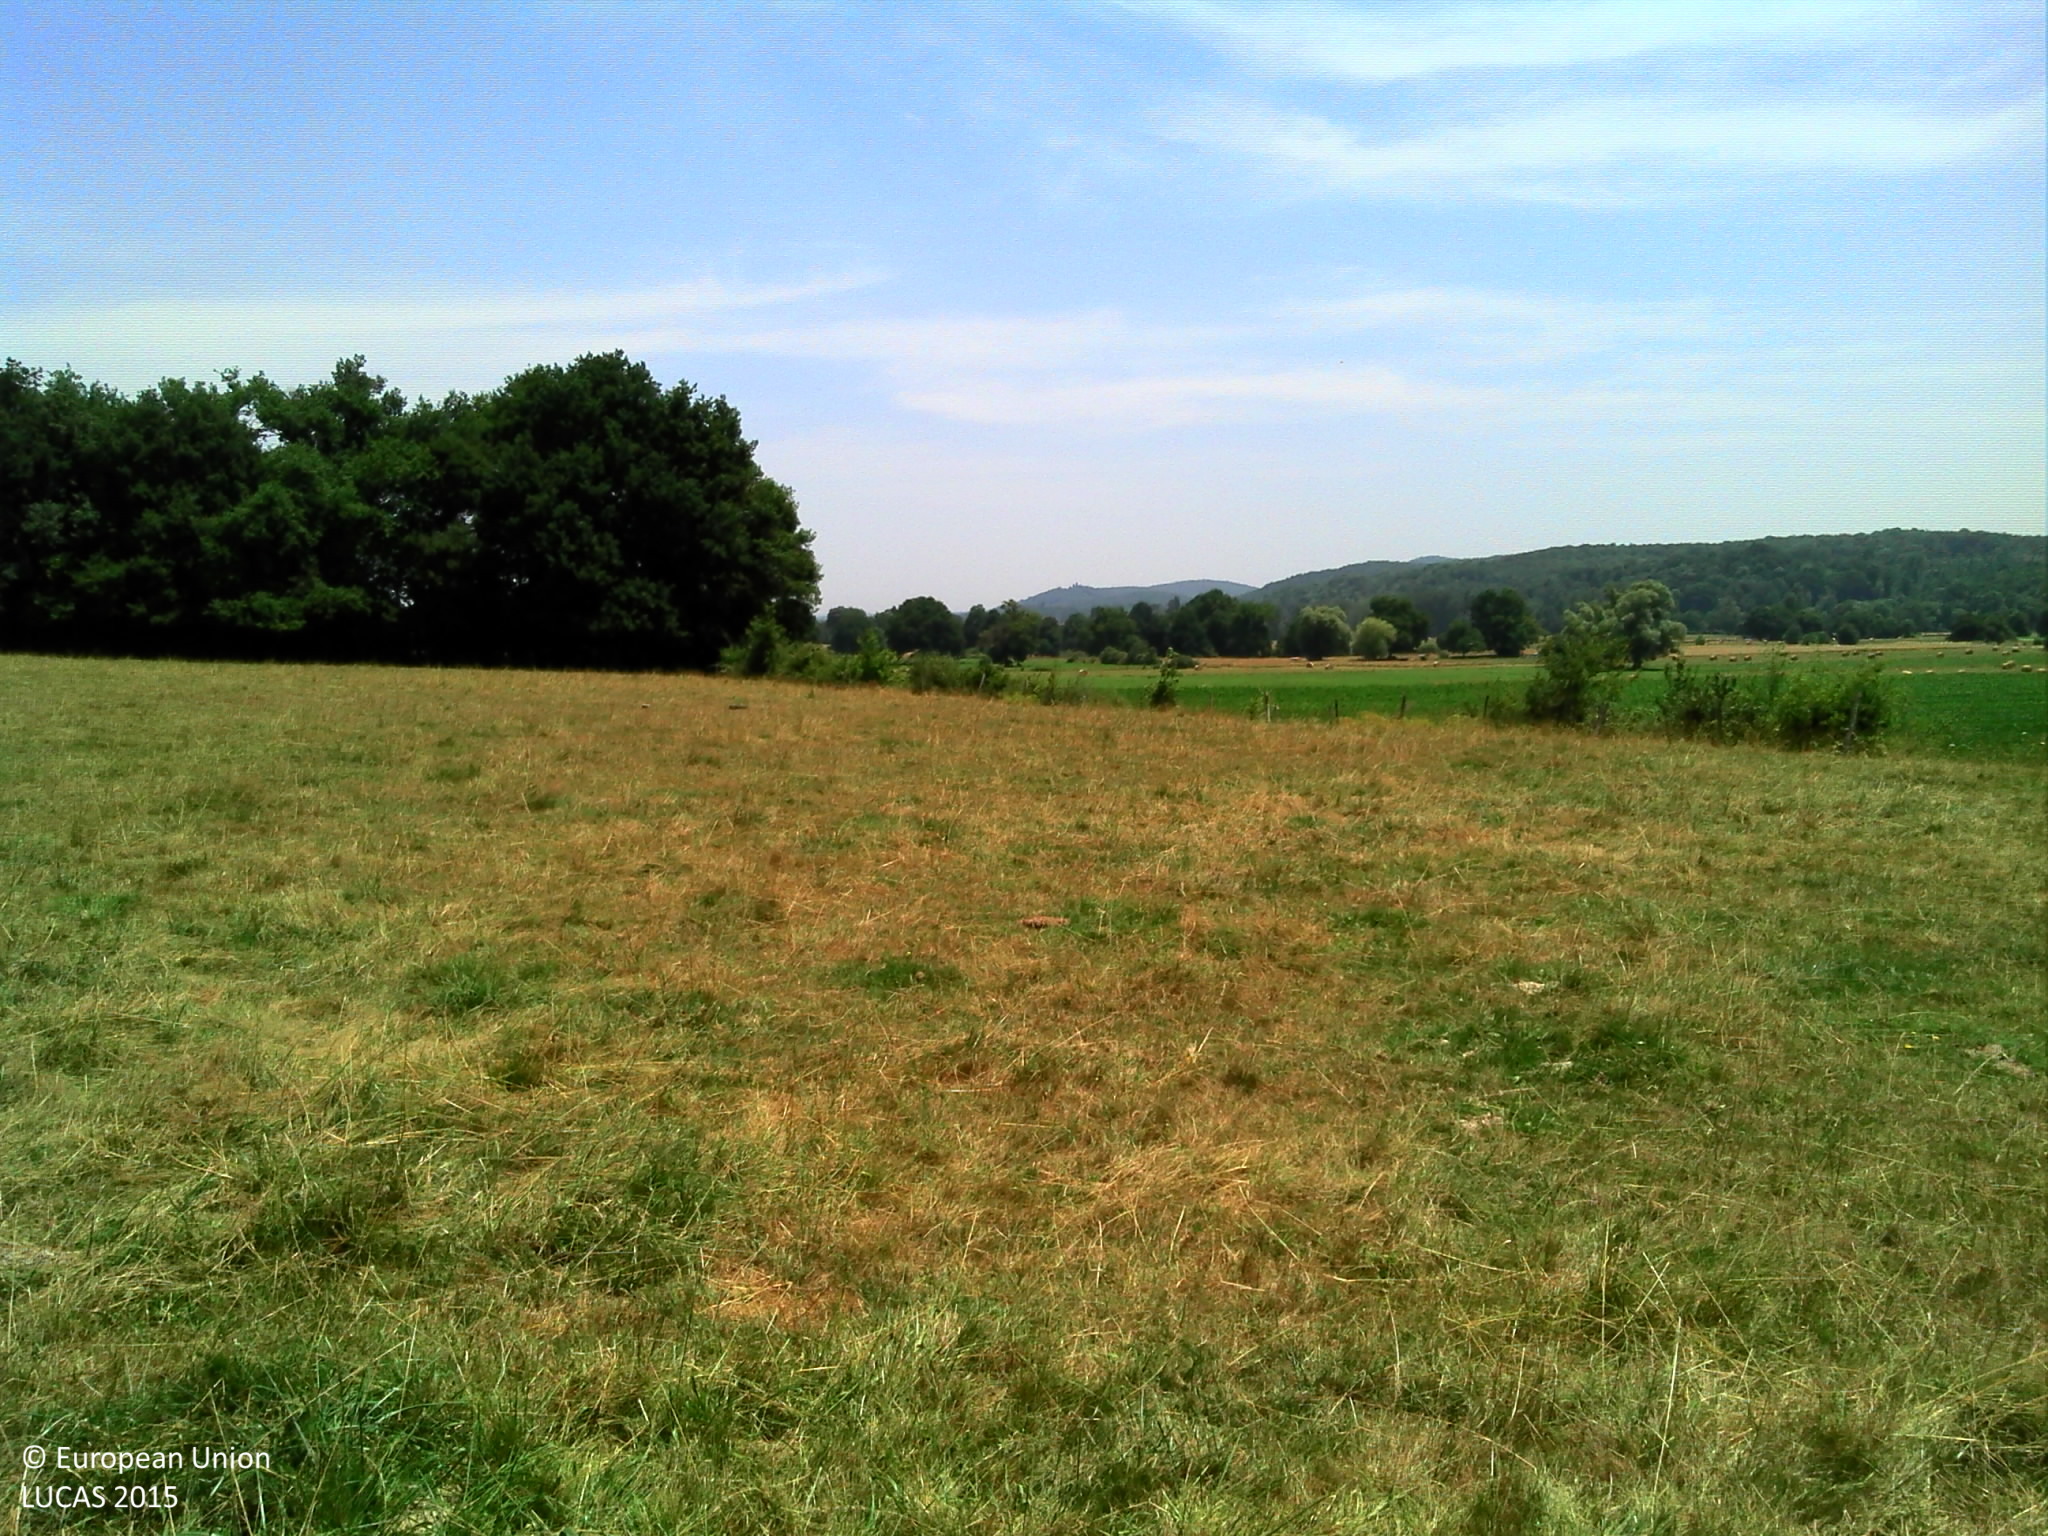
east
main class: Grassland
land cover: Grassland without tree/shrub cover
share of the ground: > 75 %
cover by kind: herbaceous plants 100 %
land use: Agriculture (excluding fallow land and kitchen gardens)
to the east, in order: Grassland without tree/shrub cover; Fences; Ditches and canals; Grass margins; Paved roads, cycling and walking lanes; Grass margins; Maize
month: July
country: FR
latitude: 43.0860
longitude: 0.7771
